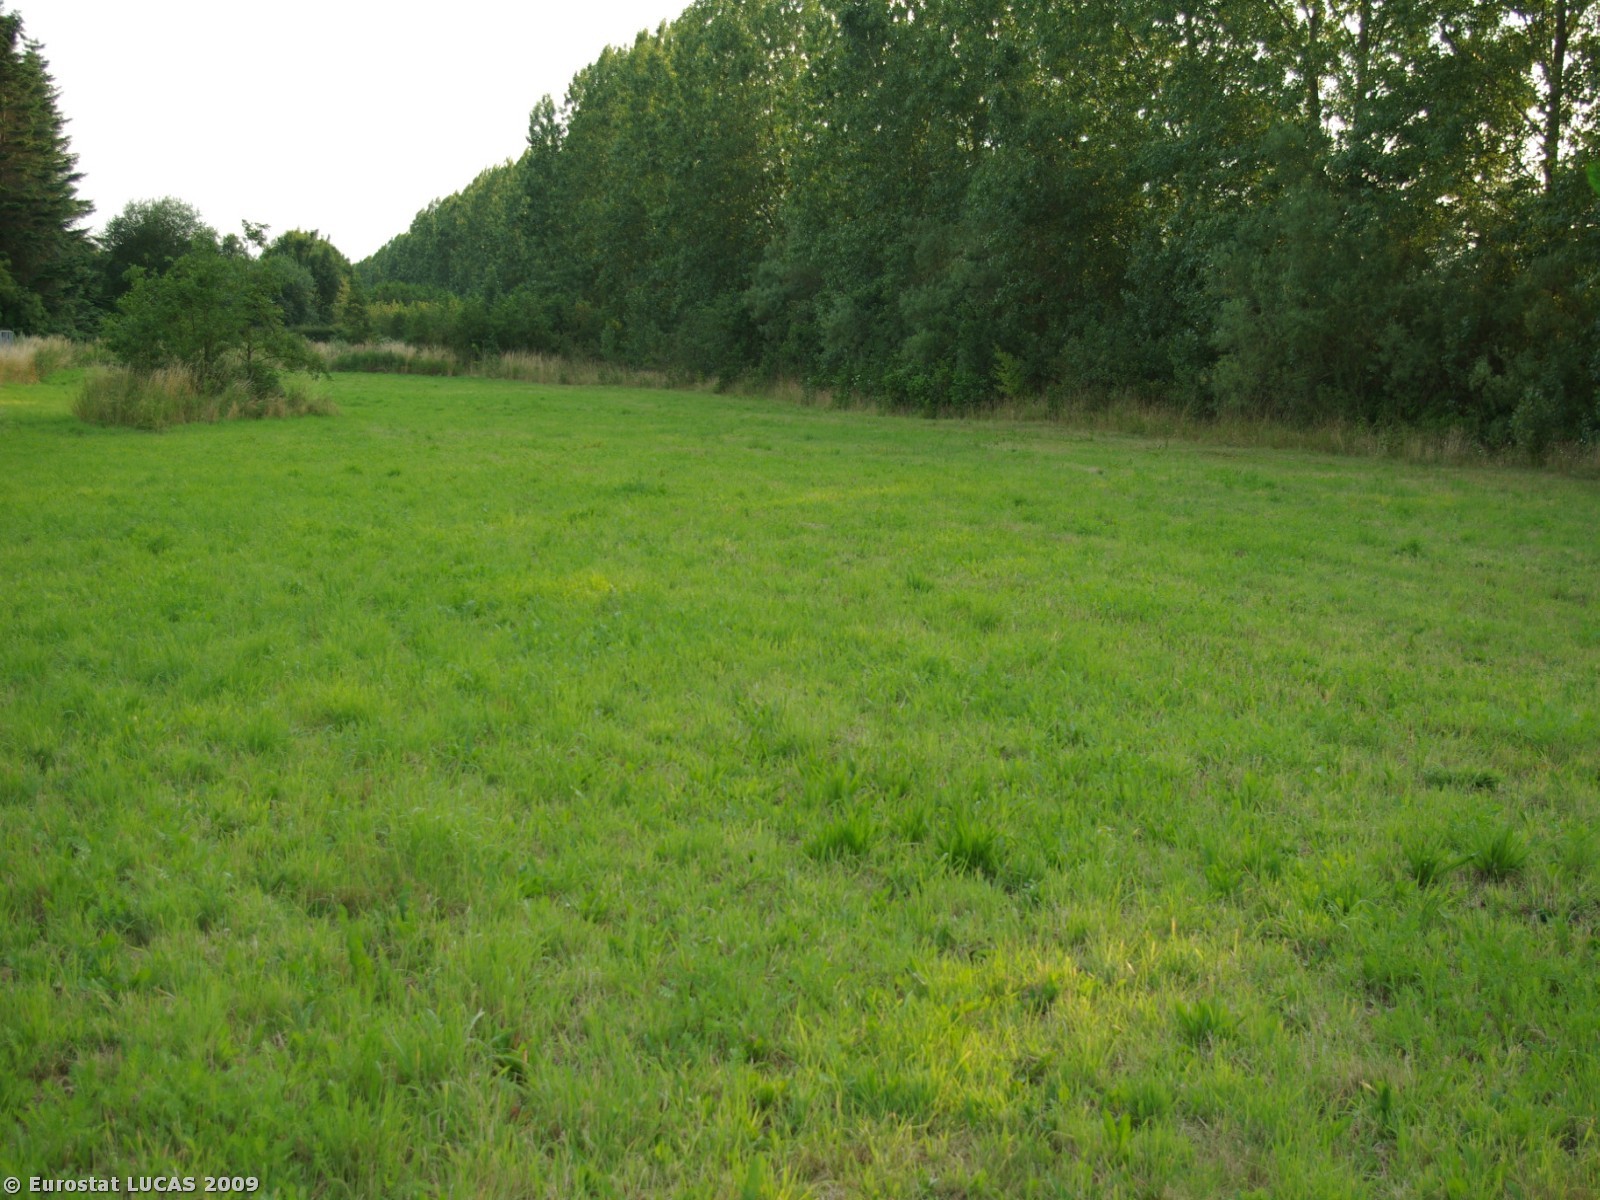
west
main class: Grassland
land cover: Grassland without tree/shrub cover
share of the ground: > 75 %
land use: Agriculture (excluding fallow land and kitchen gardens)
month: July
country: DK
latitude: 54.9294
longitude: 9.7973
